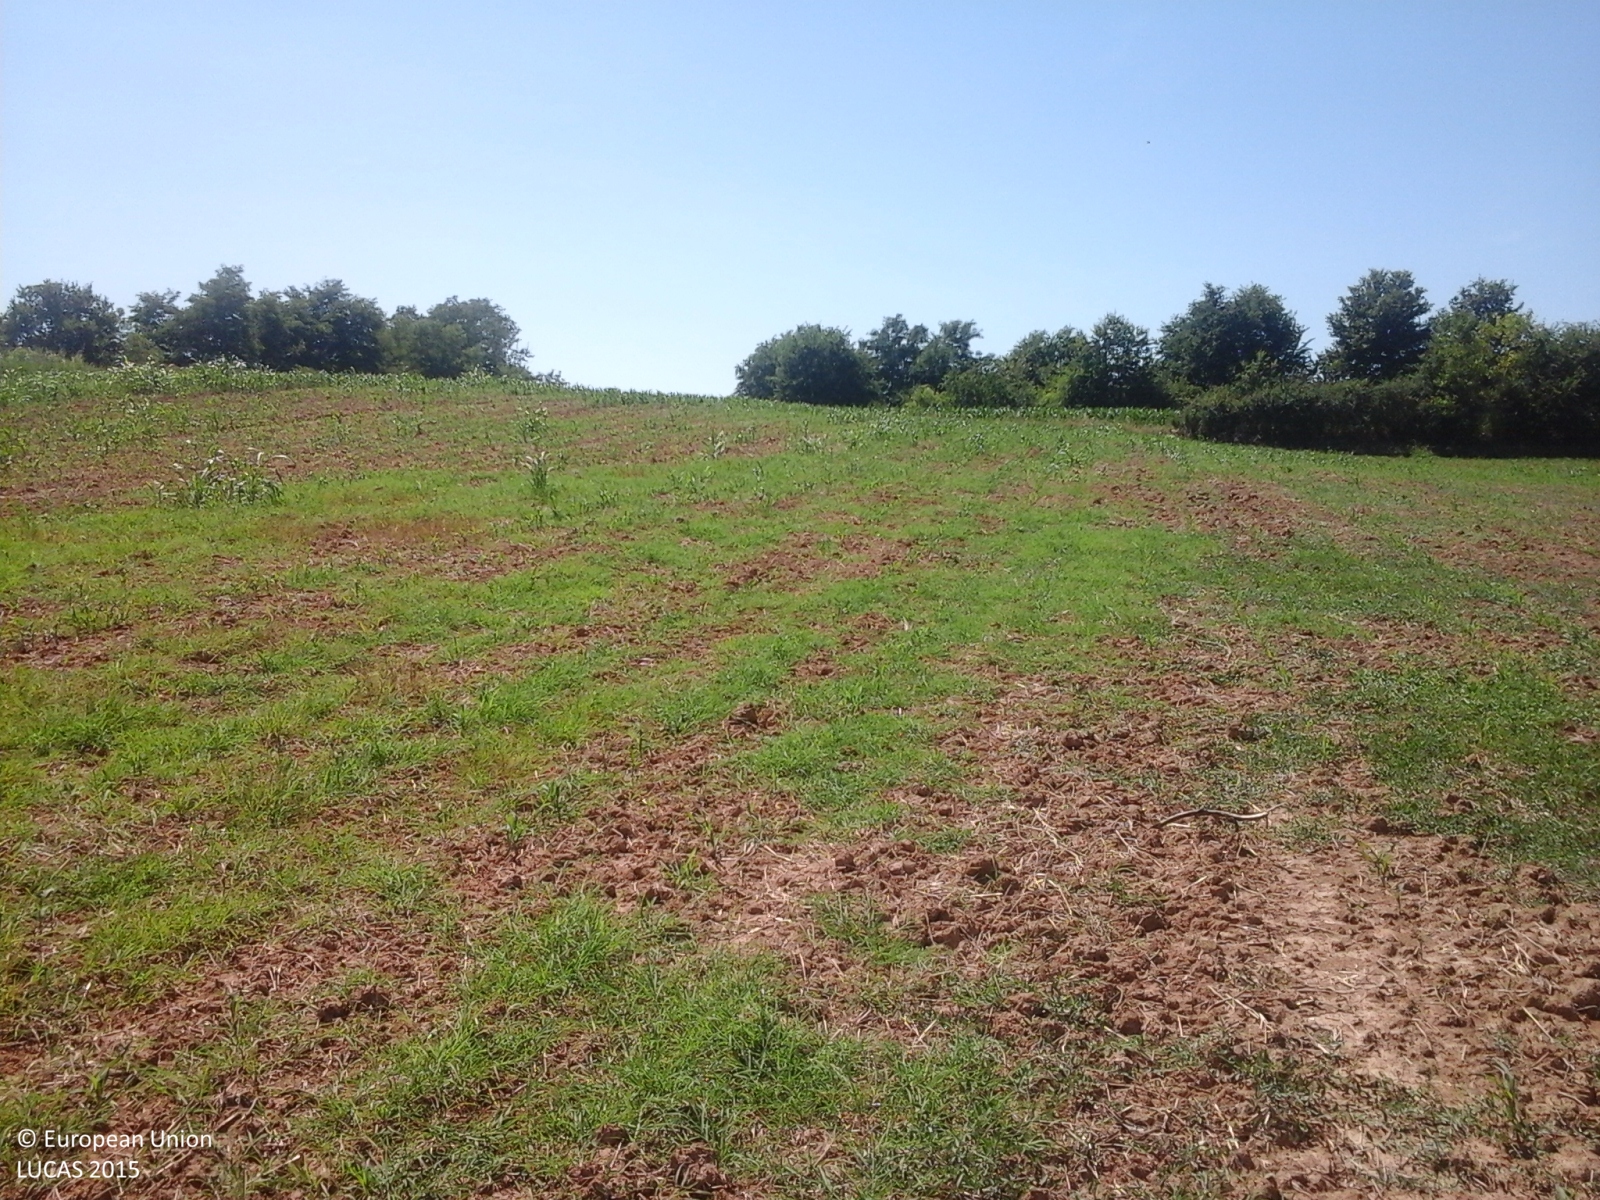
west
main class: Grassland
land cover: Grassland without tree/shrub cover
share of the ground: 50 - 75 %
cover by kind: herbaceous plants 65 %, unconsolidated bare surface 35 %
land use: Agriculture (excluding fallow land and kitchen gardens)
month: June
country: IT
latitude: 45.0444
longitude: 8.5934
